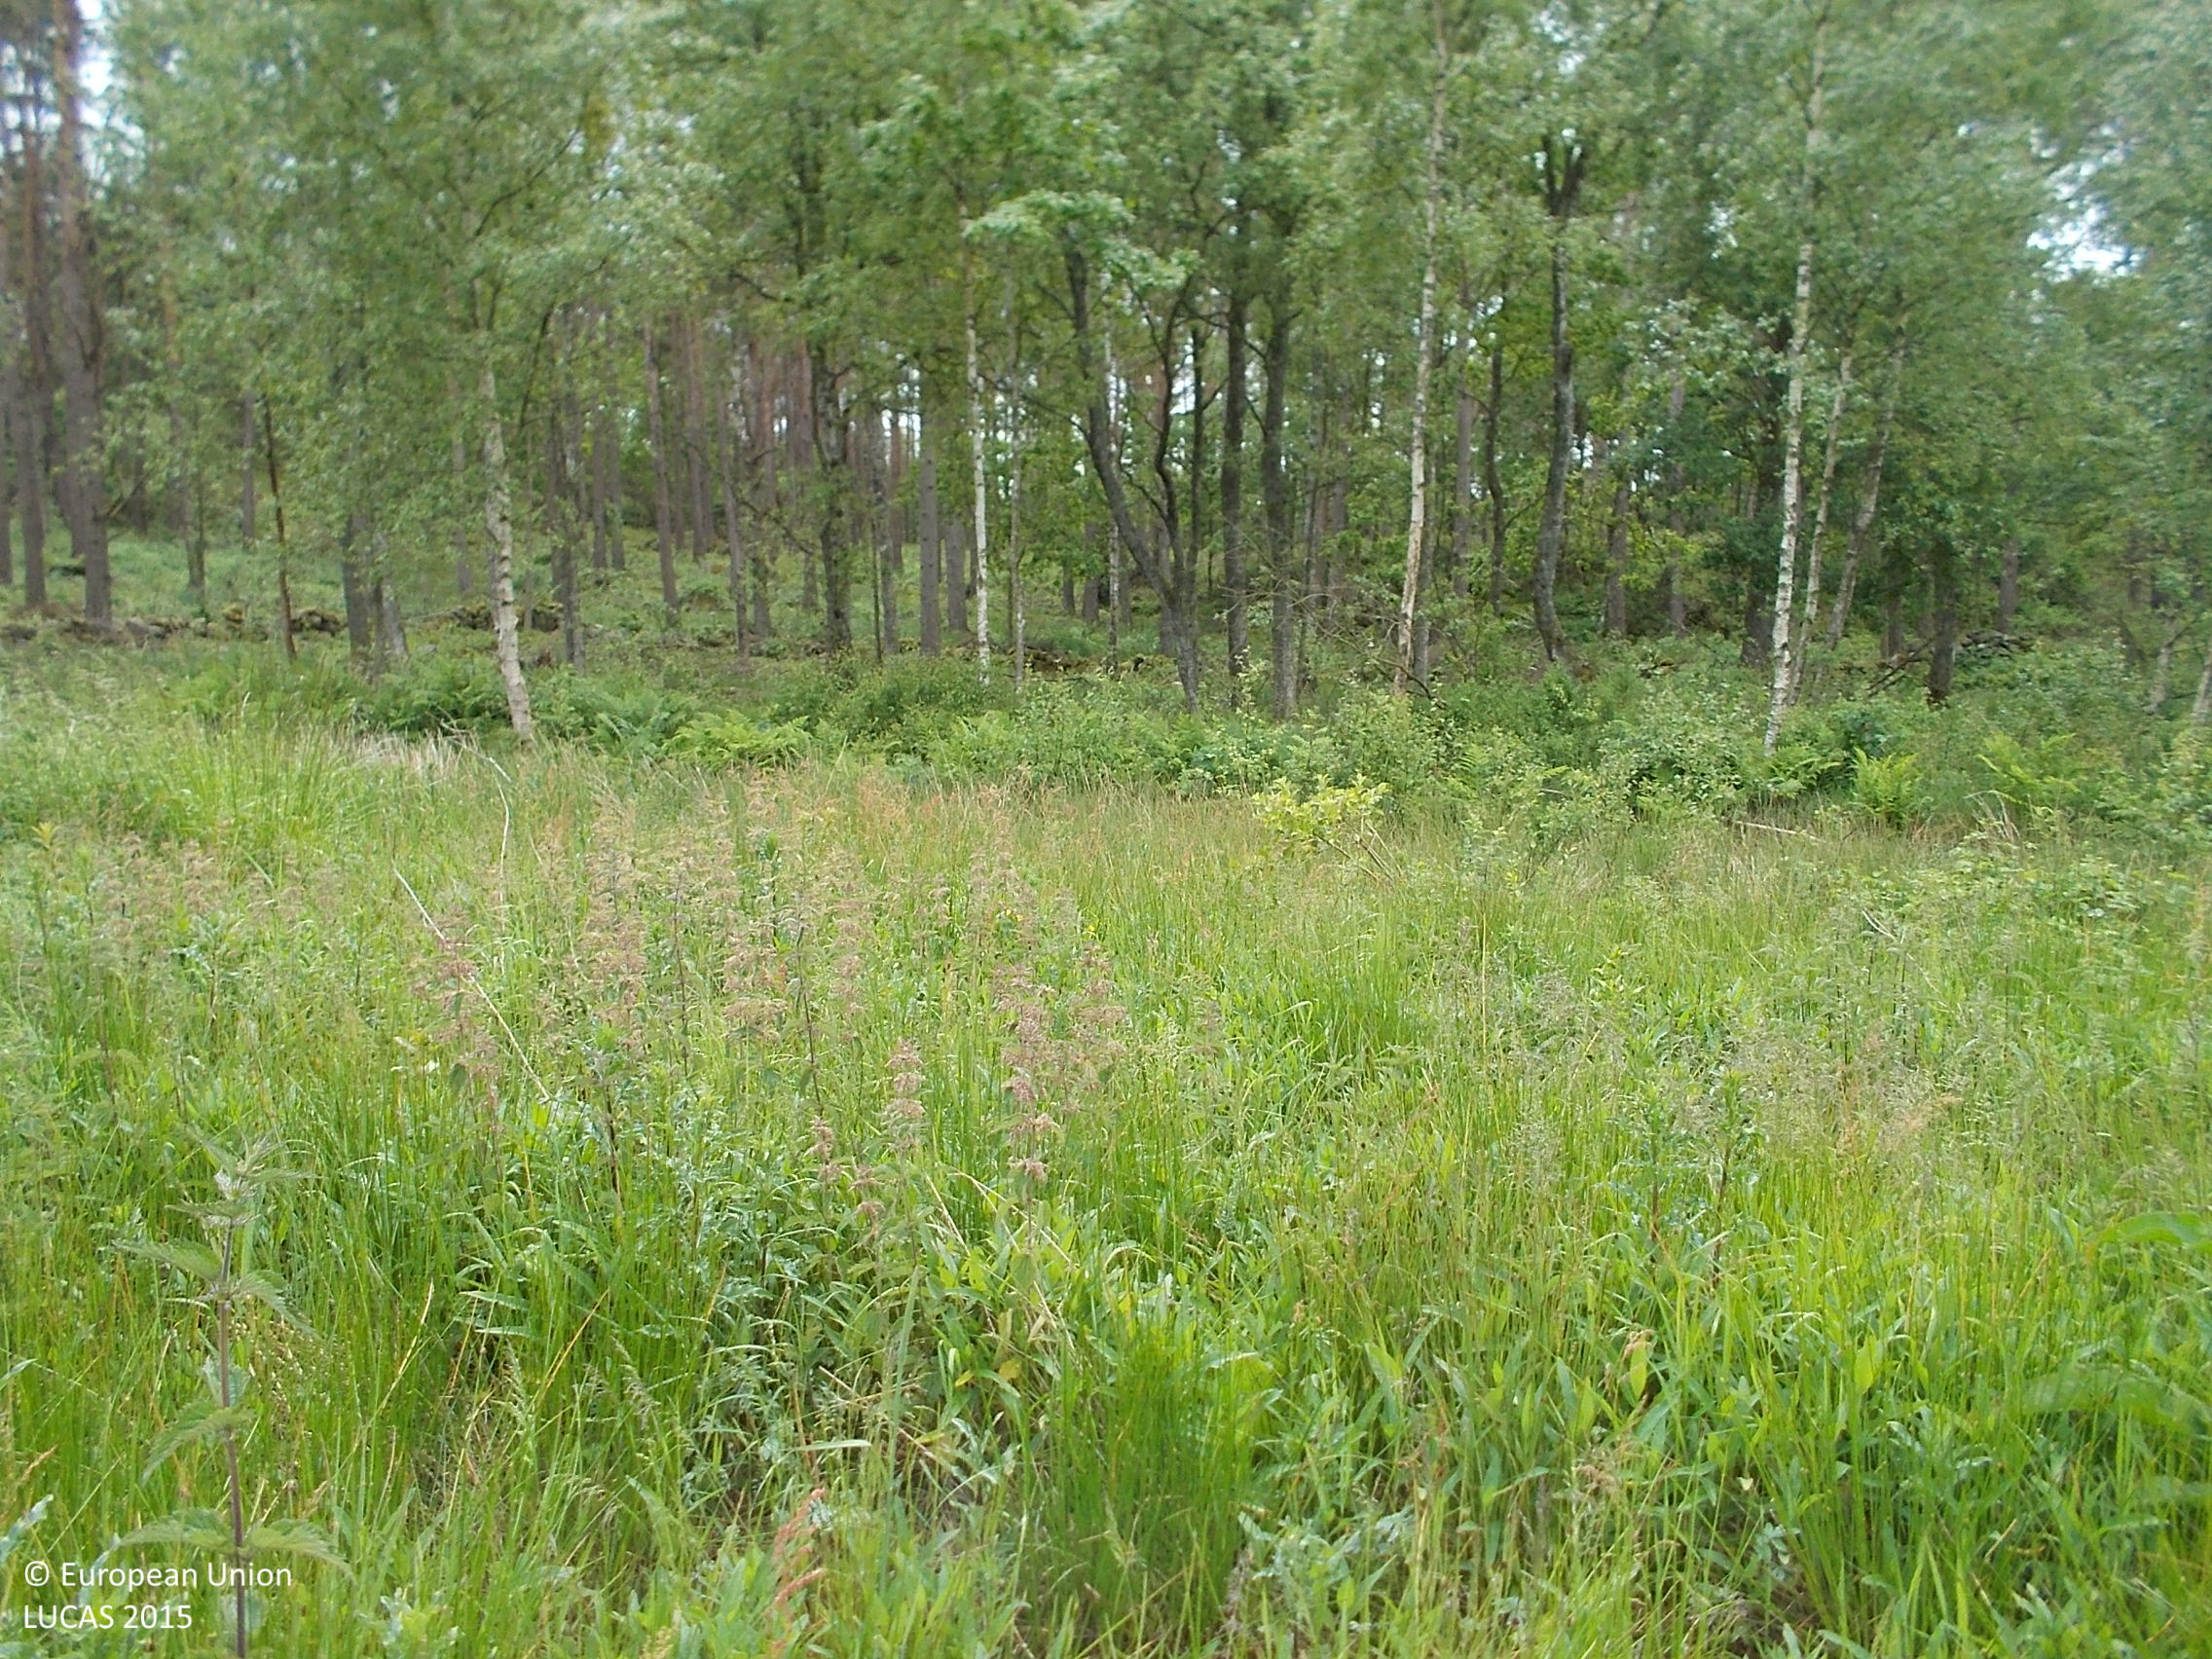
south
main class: Grassland
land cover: Spontaneously vegetated surfaces
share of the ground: > 75 %
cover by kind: herbaceous plants 95 %, shrubs 5 %
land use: Fallow land
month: June
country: SE
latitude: 57.4499
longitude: 11.9467
